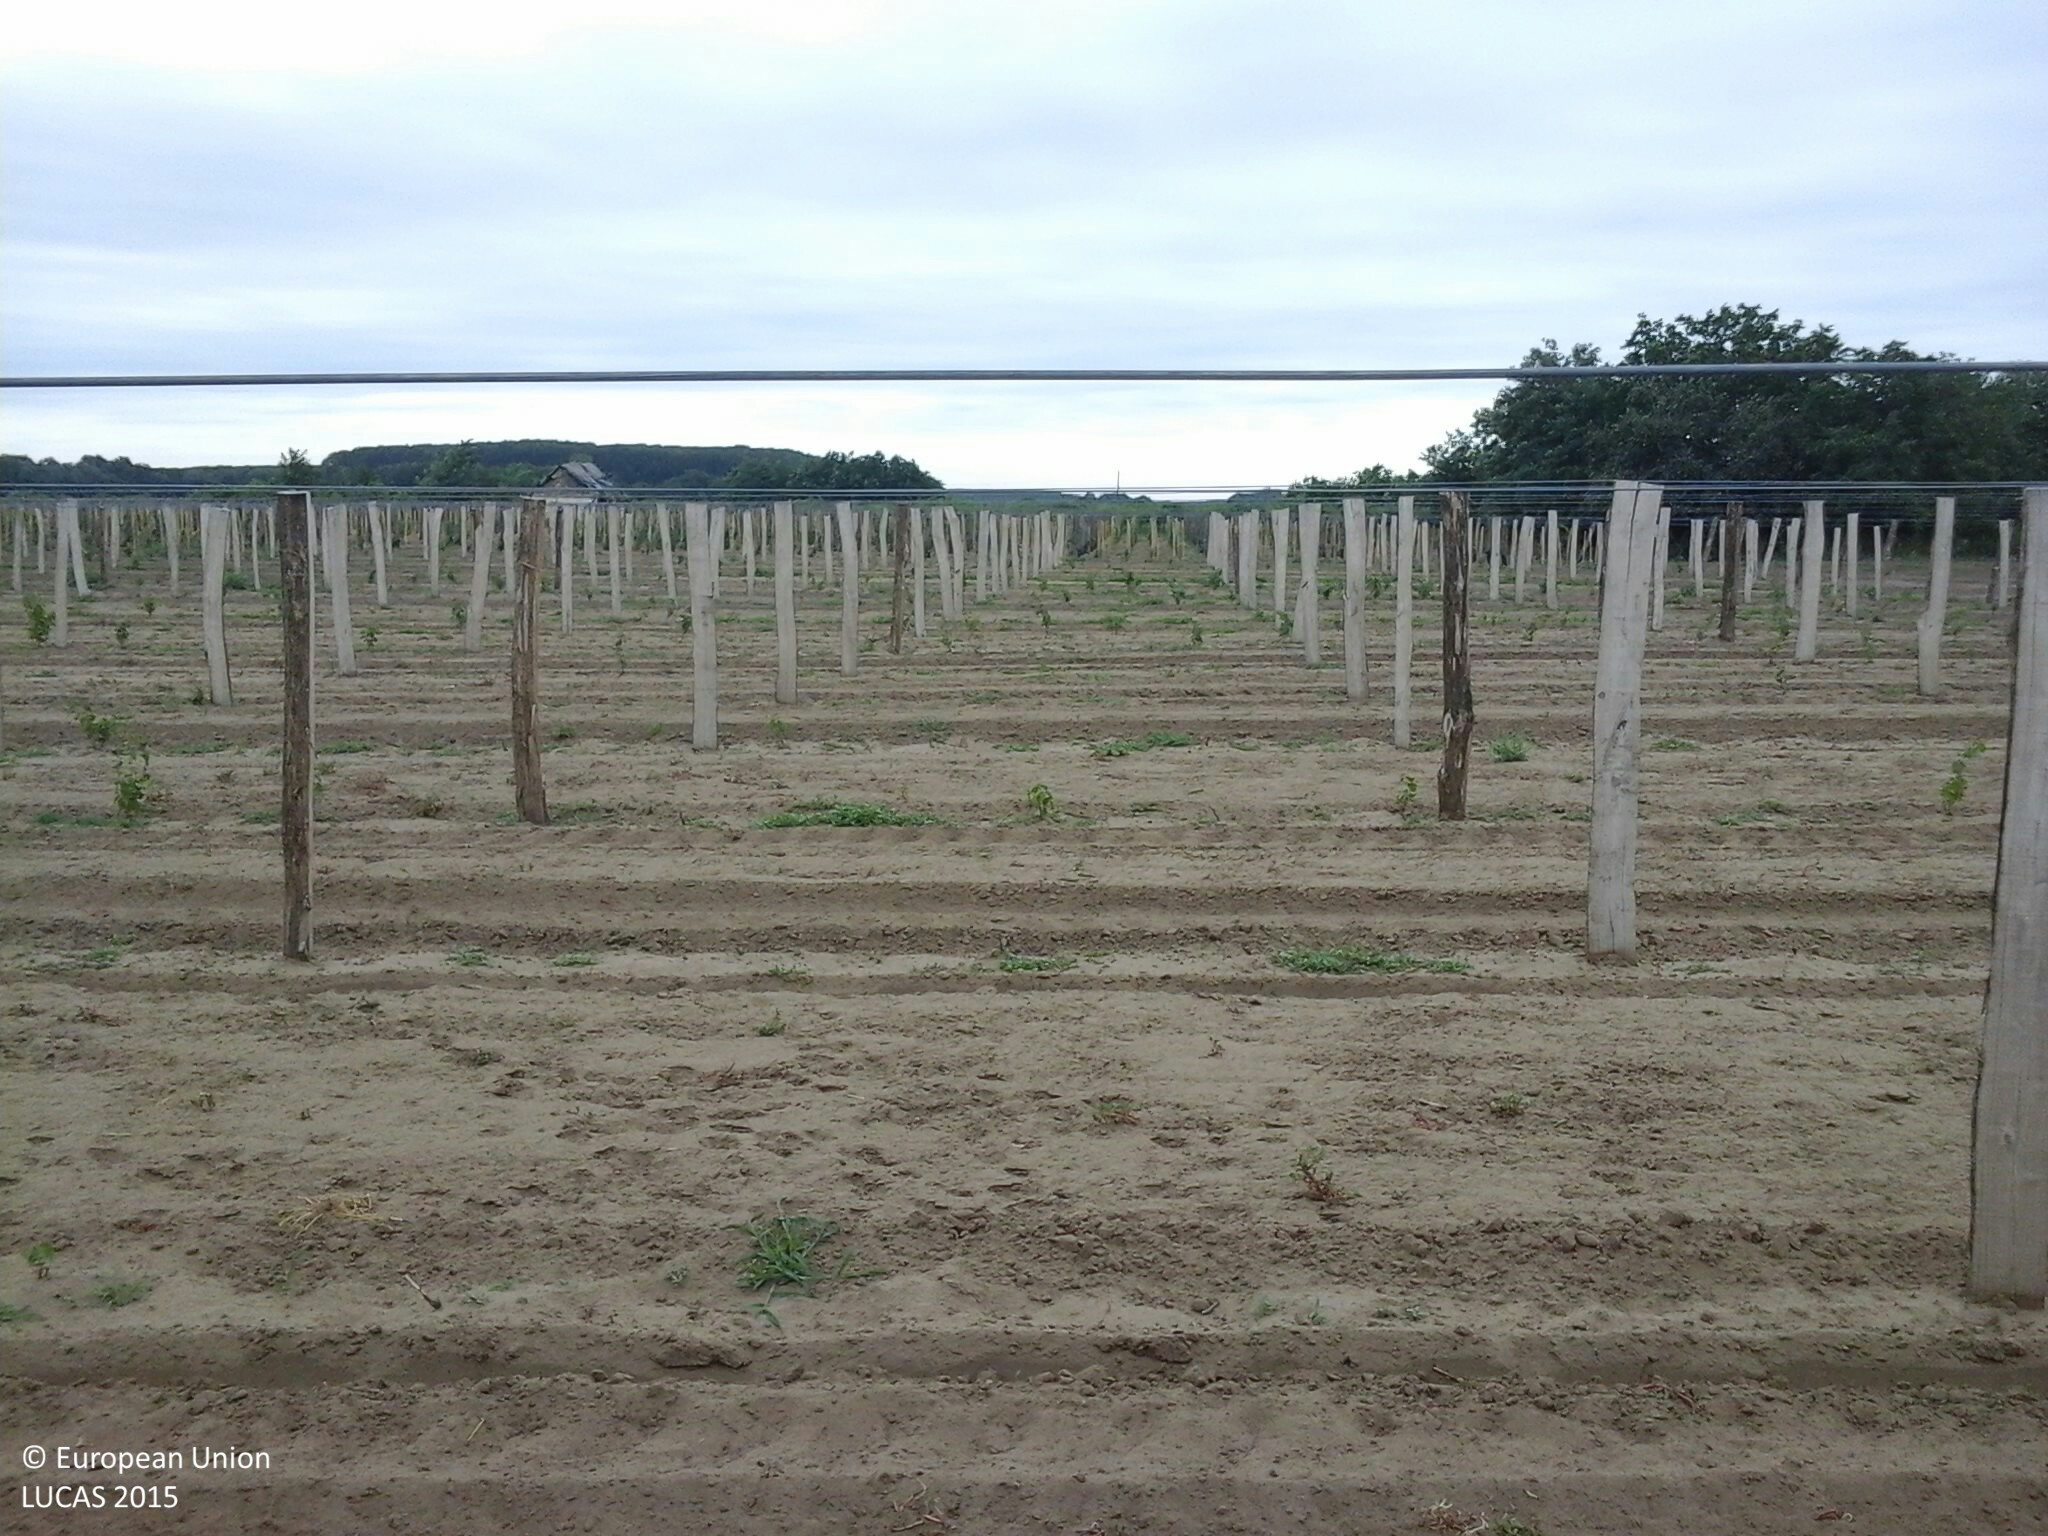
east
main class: Cropland
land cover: Vineyards
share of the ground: 25 - 50 %
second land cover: Other bare soil
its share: > 75 %
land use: Agriculture (excluding fallow land and kitchen gardens)
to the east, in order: Vineyards; Other bare soil; Tracks; Vineyards; Tracks; Spontaneously vegetated surfaces
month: July
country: HU
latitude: 46.8484
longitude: 20.1355
